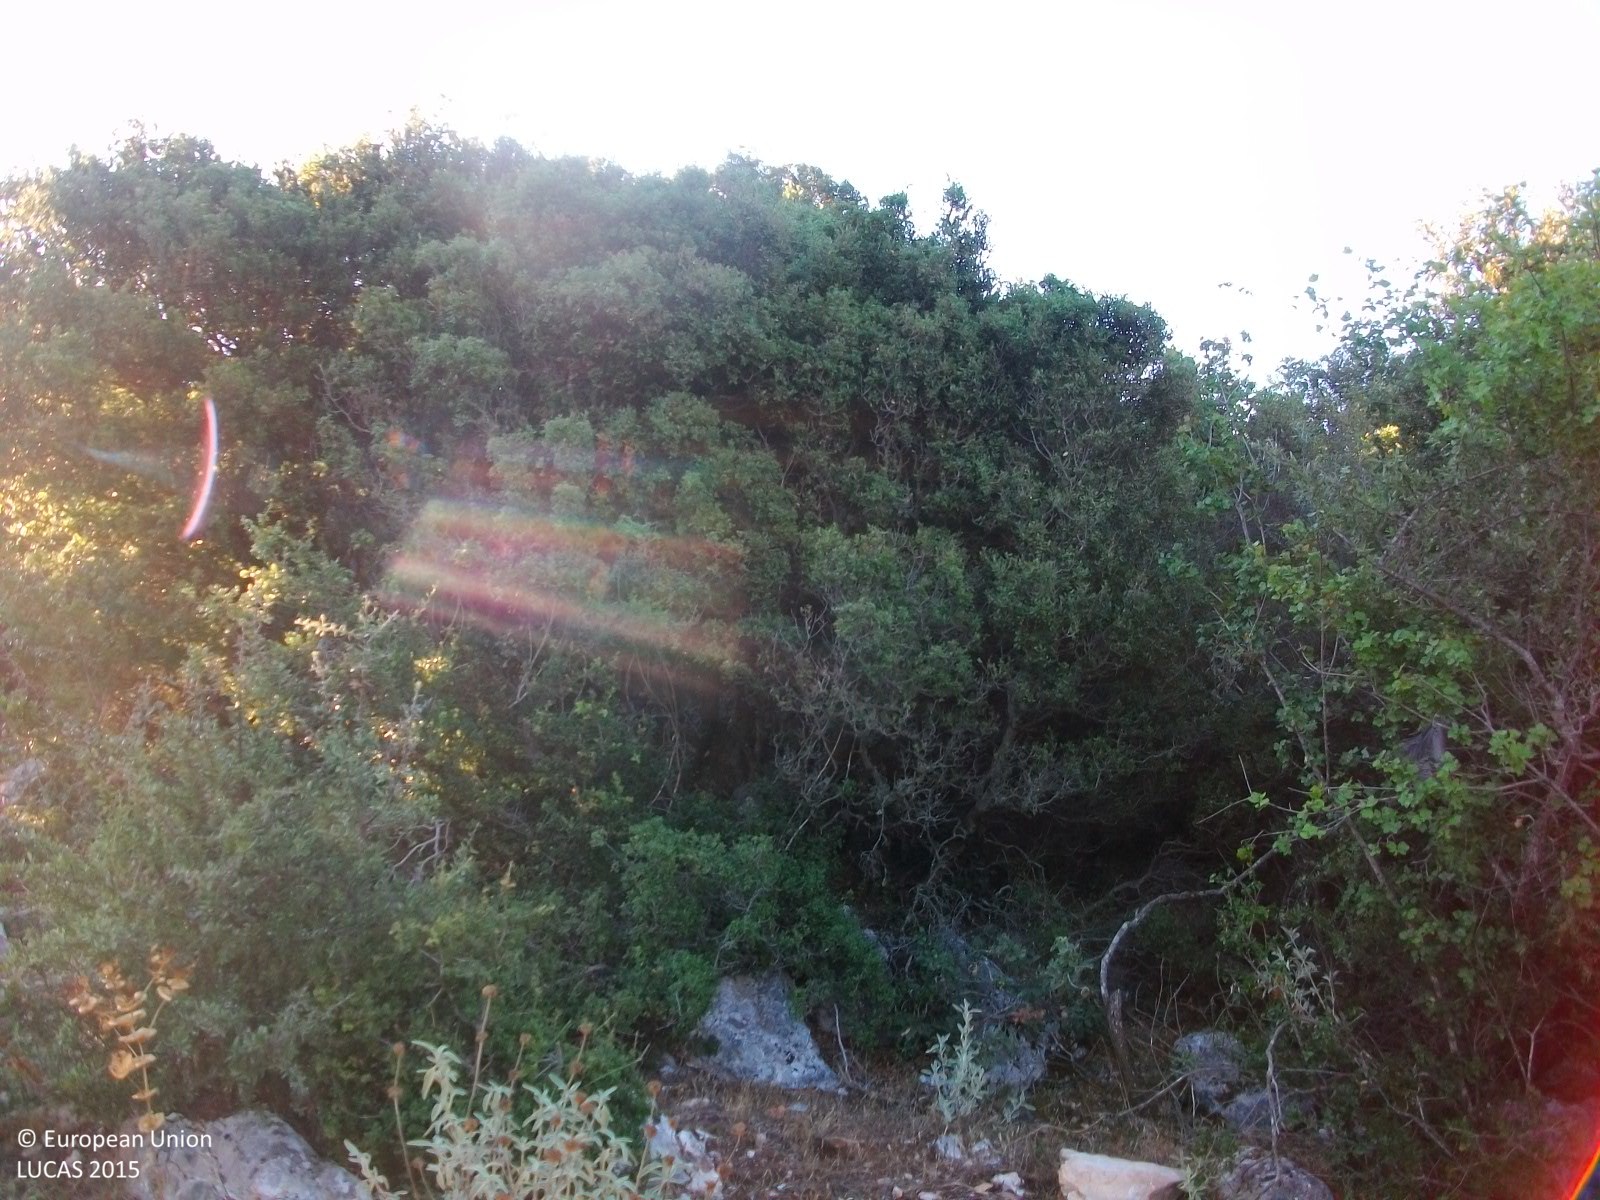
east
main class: Woodland
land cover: Broadleaved woodland
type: broadleaved evergreen forest
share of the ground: > 75 %
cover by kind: broadleaved forest trees 100 %
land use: Semi-natural and natural areas not in use
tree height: > 5 m
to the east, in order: Broadleaved woodland; Rivers and streams; Broadleaved woodland
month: July
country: GR
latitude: 36.9469
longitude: 21.8652
